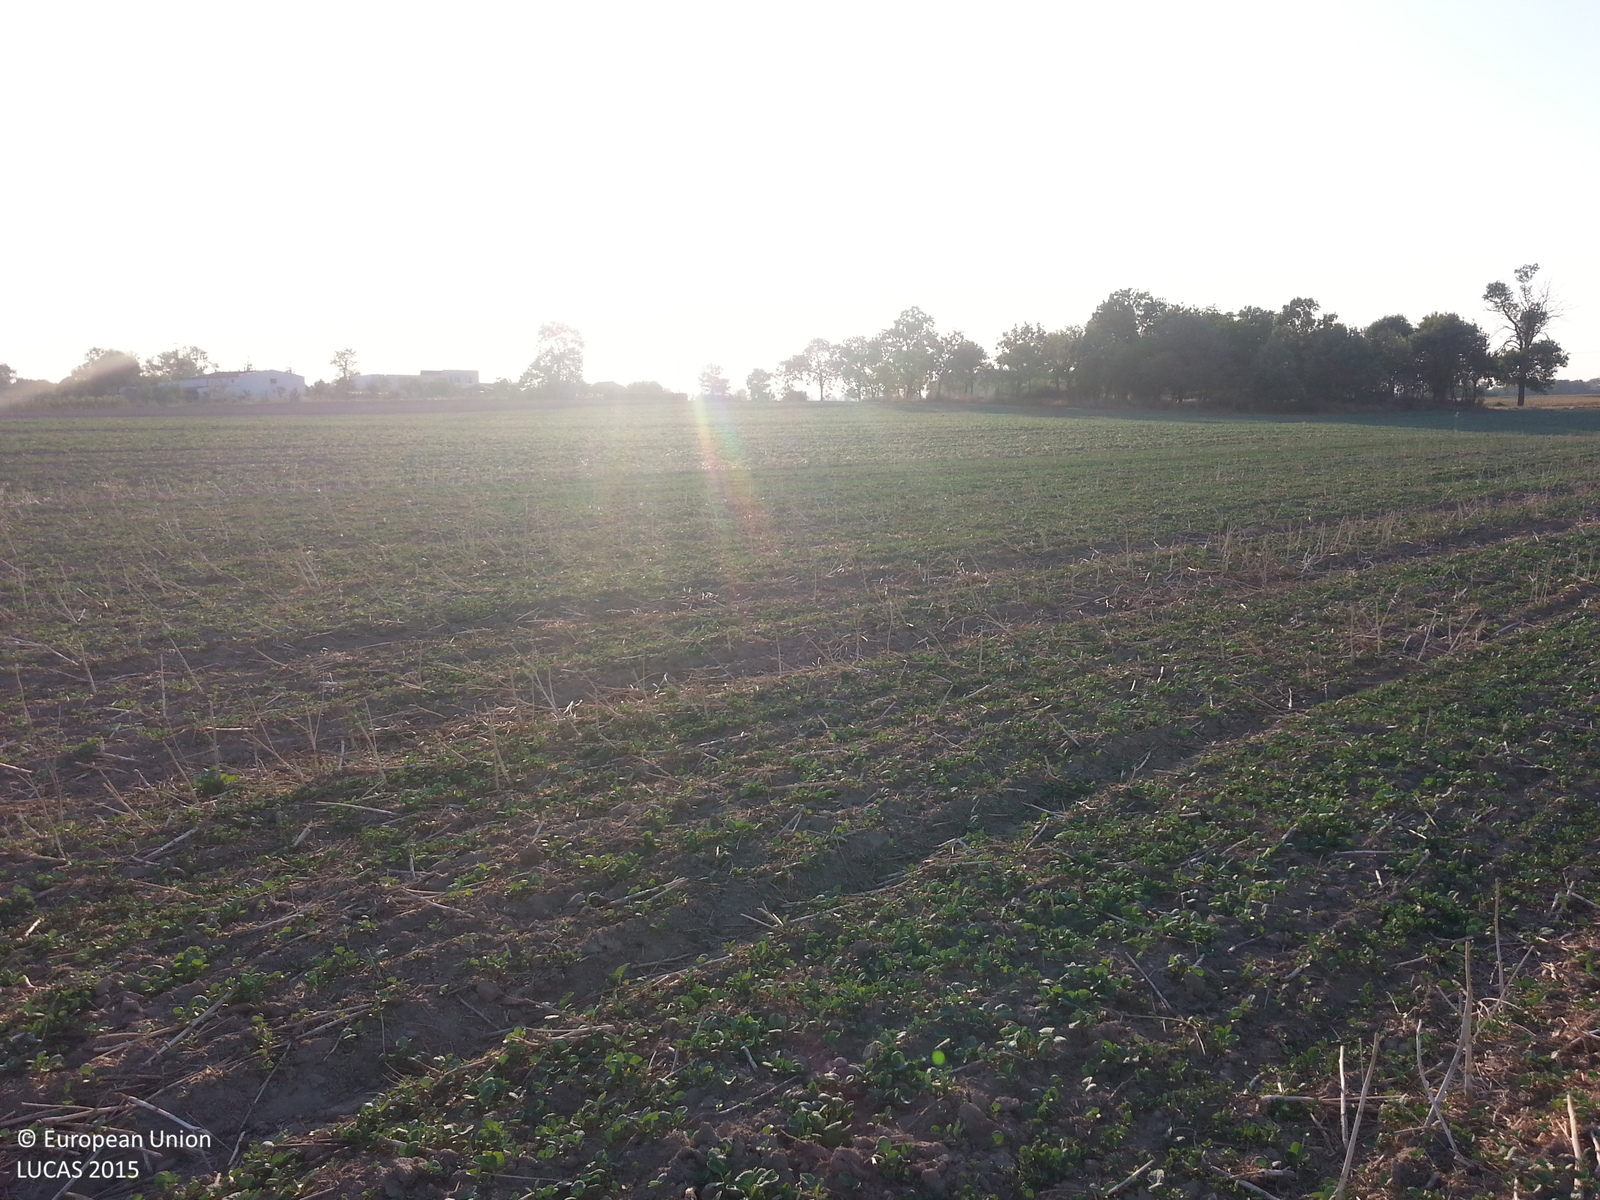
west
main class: Cropland
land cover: Rape and turnip rape
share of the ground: 25 - 50 %
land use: Agriculture (excluding fallow land and kitchen gardens)
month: August
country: PL
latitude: 52.7714
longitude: 18.0643
